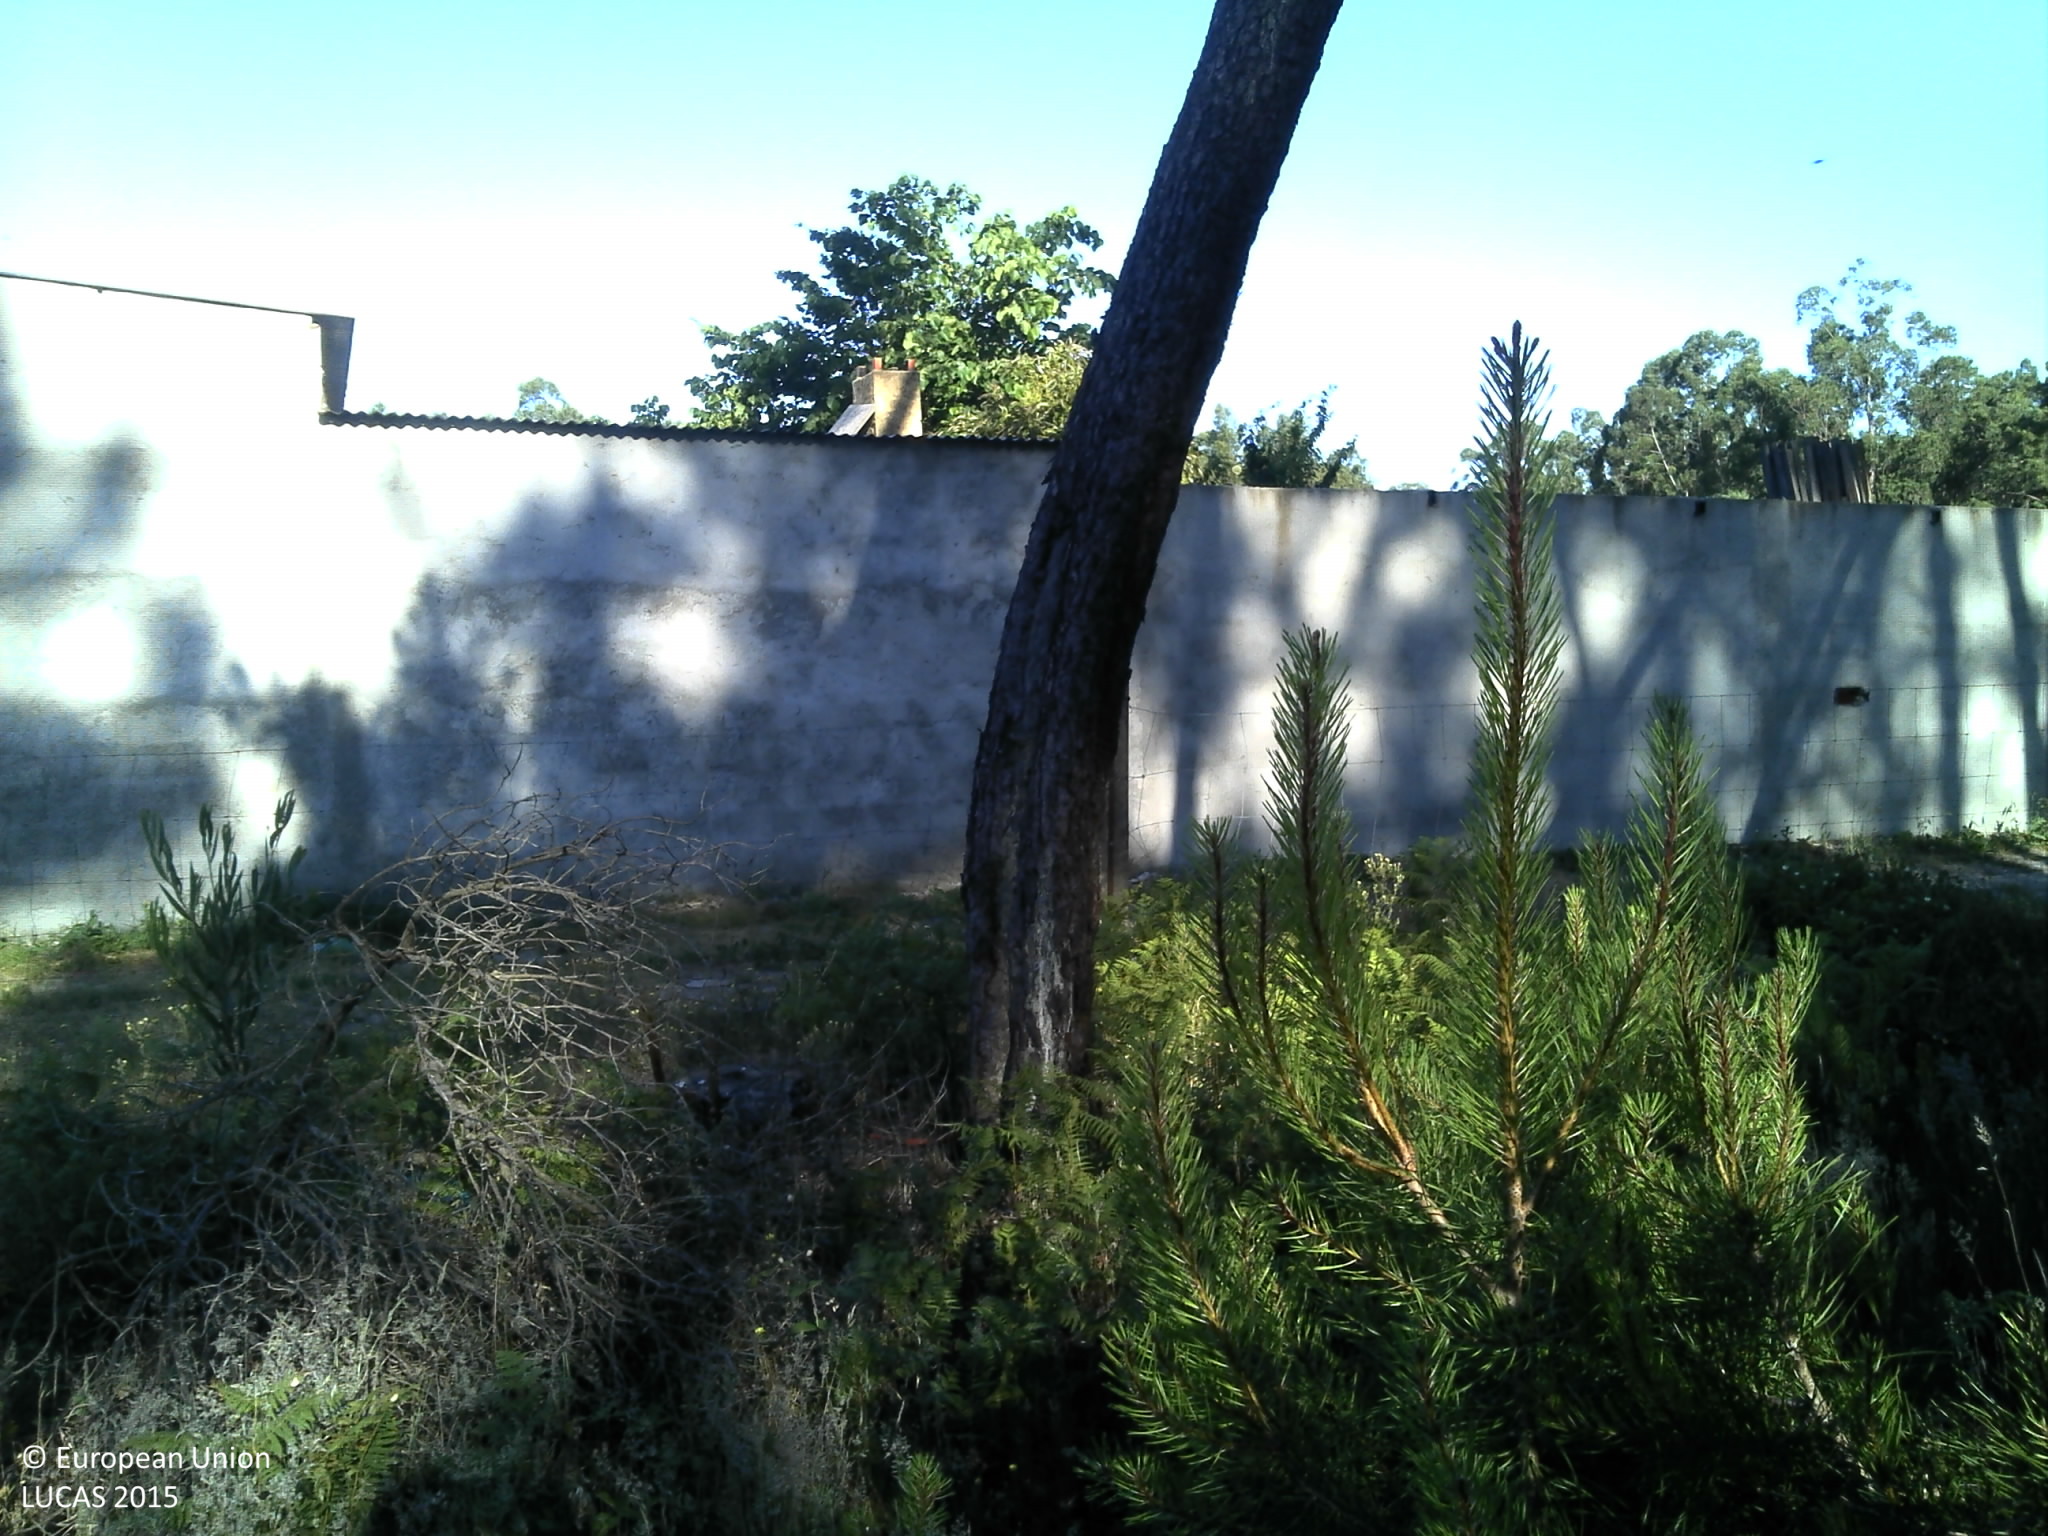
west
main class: Woodland
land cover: Pine dominated coniferous woodland
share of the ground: 25 - 50 %
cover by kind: coniferous forest trees 50 %, shrubs 30 %, herbaceous plants 10 %, consolidated bare surface 5 %, unconsolidated bare surface 5 %
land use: Forestry
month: May
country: PT
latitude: 40.4782
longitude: -8.6497
